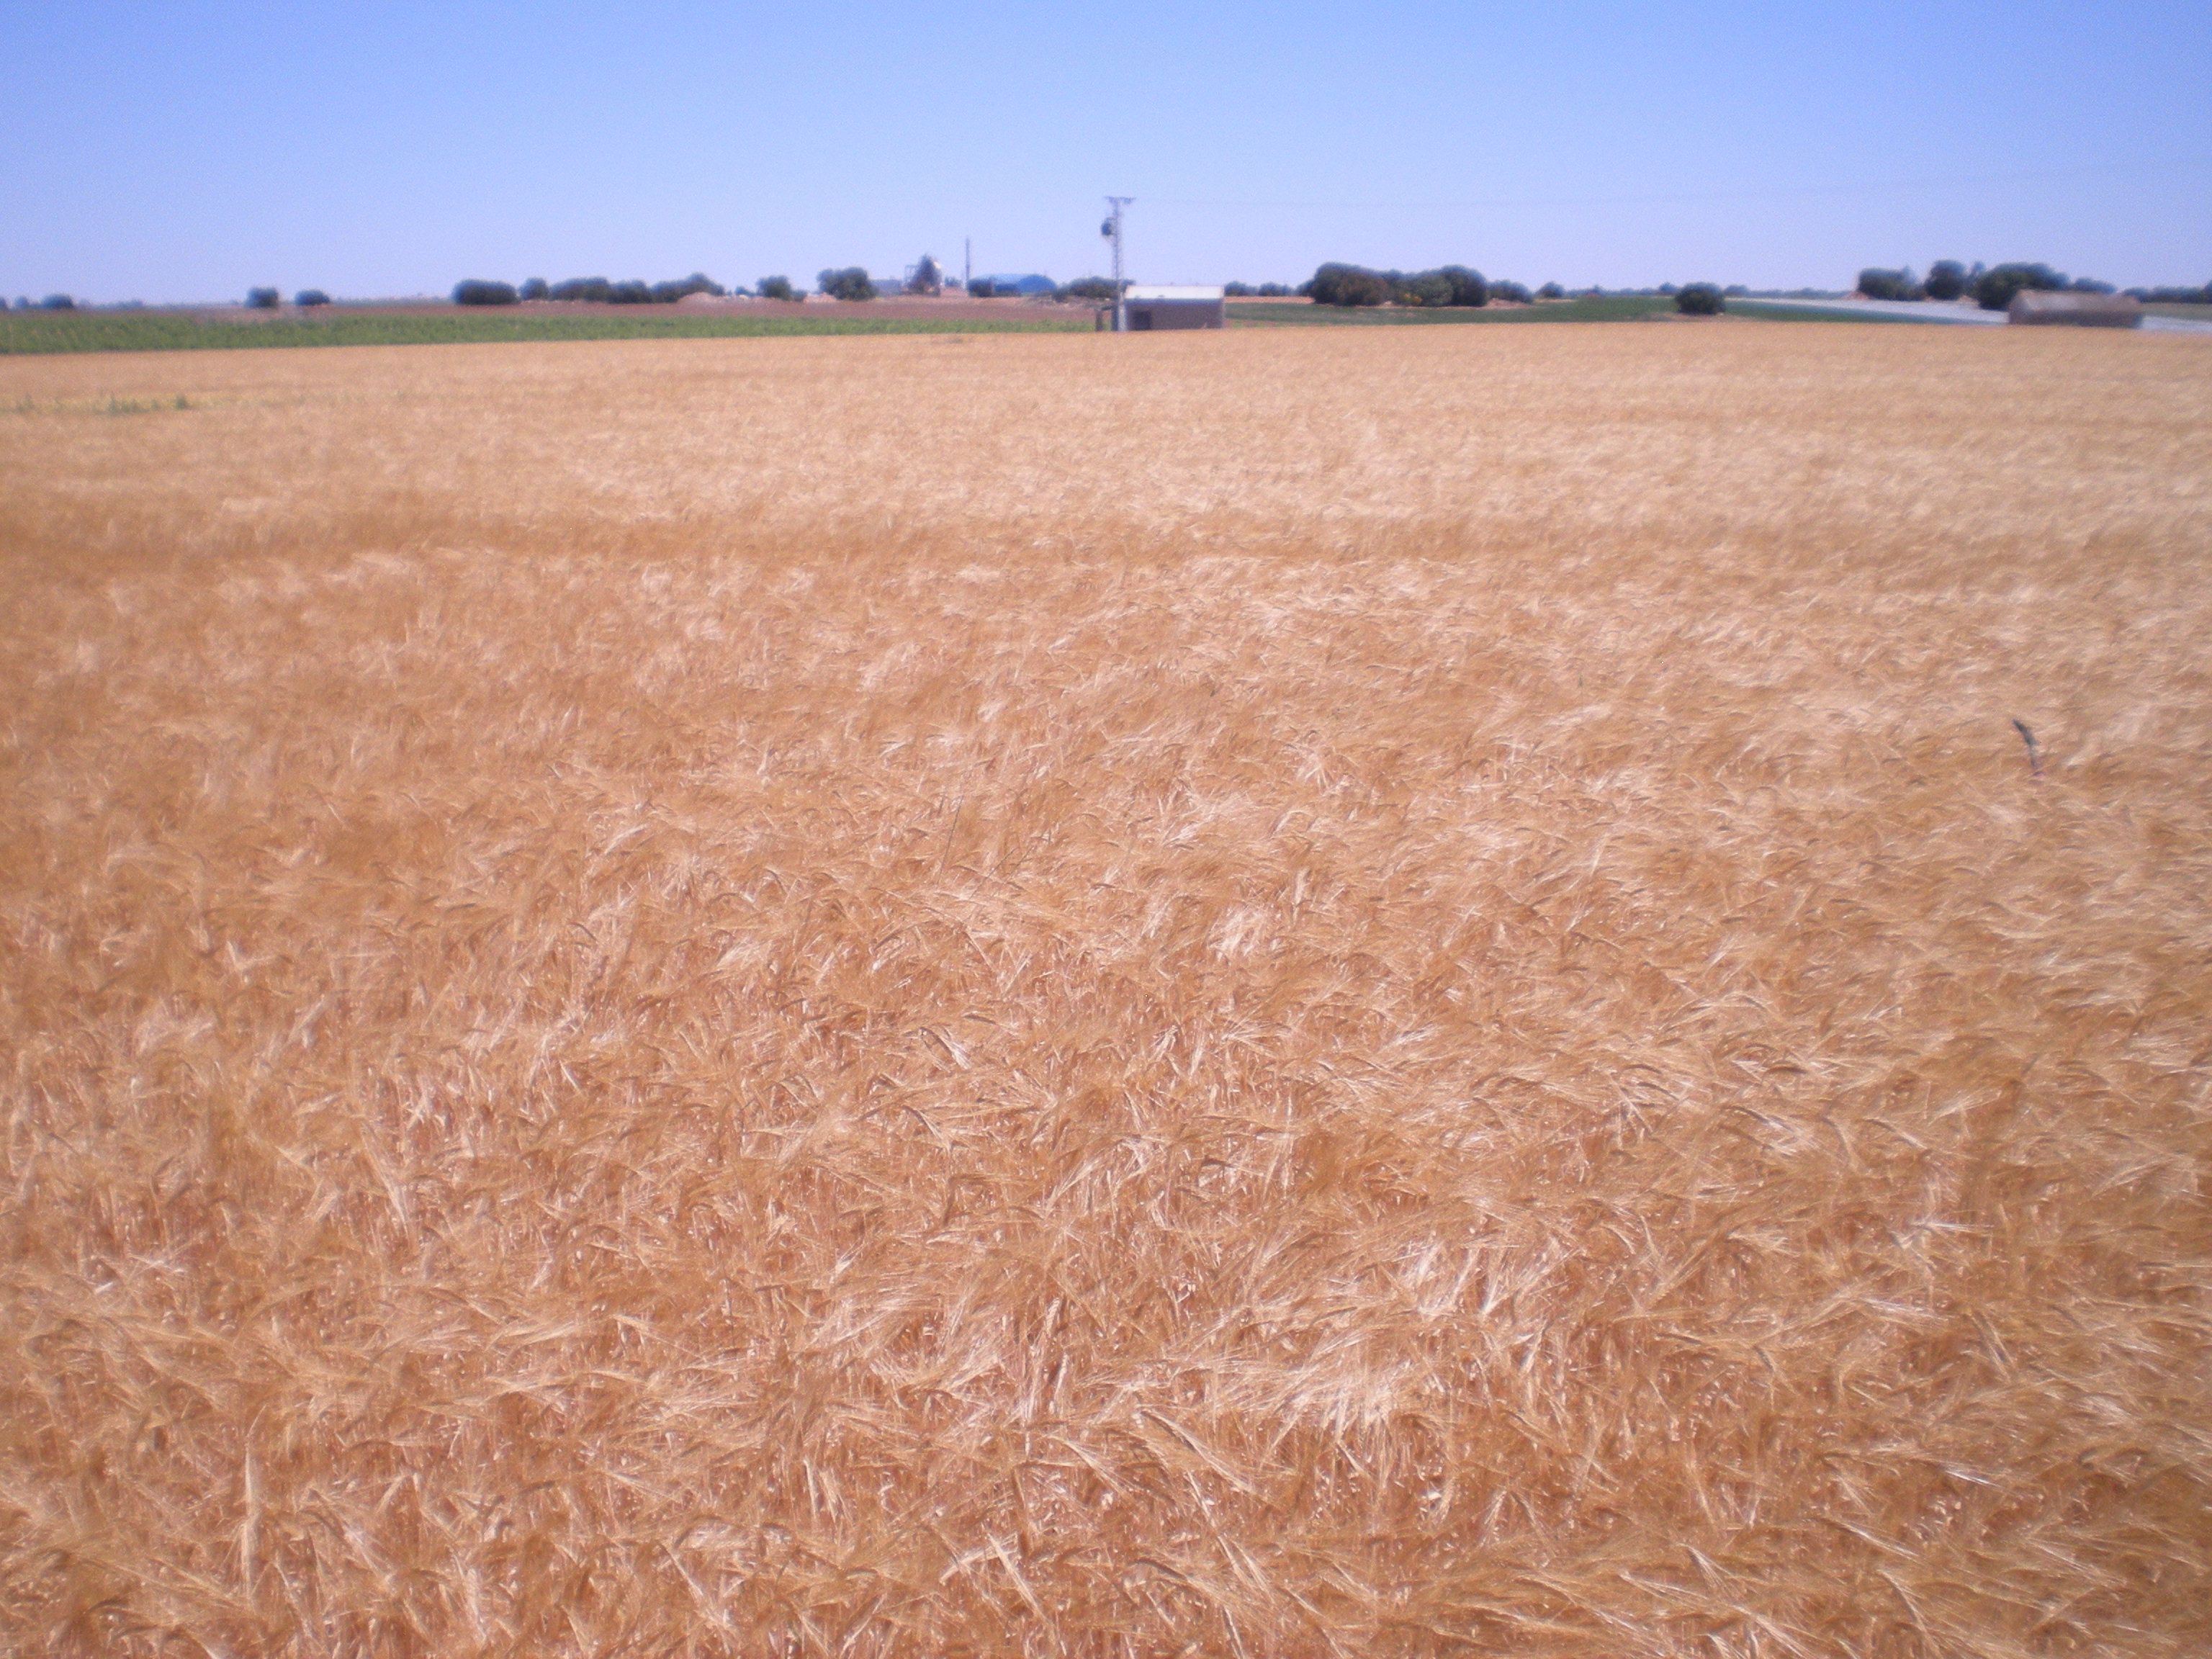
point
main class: Cropland
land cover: Barley
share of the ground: > 75 %
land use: Agriculture (excluding fallow land and kitchen gardens)
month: May
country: ES
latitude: 39.2065
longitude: -3.4630
